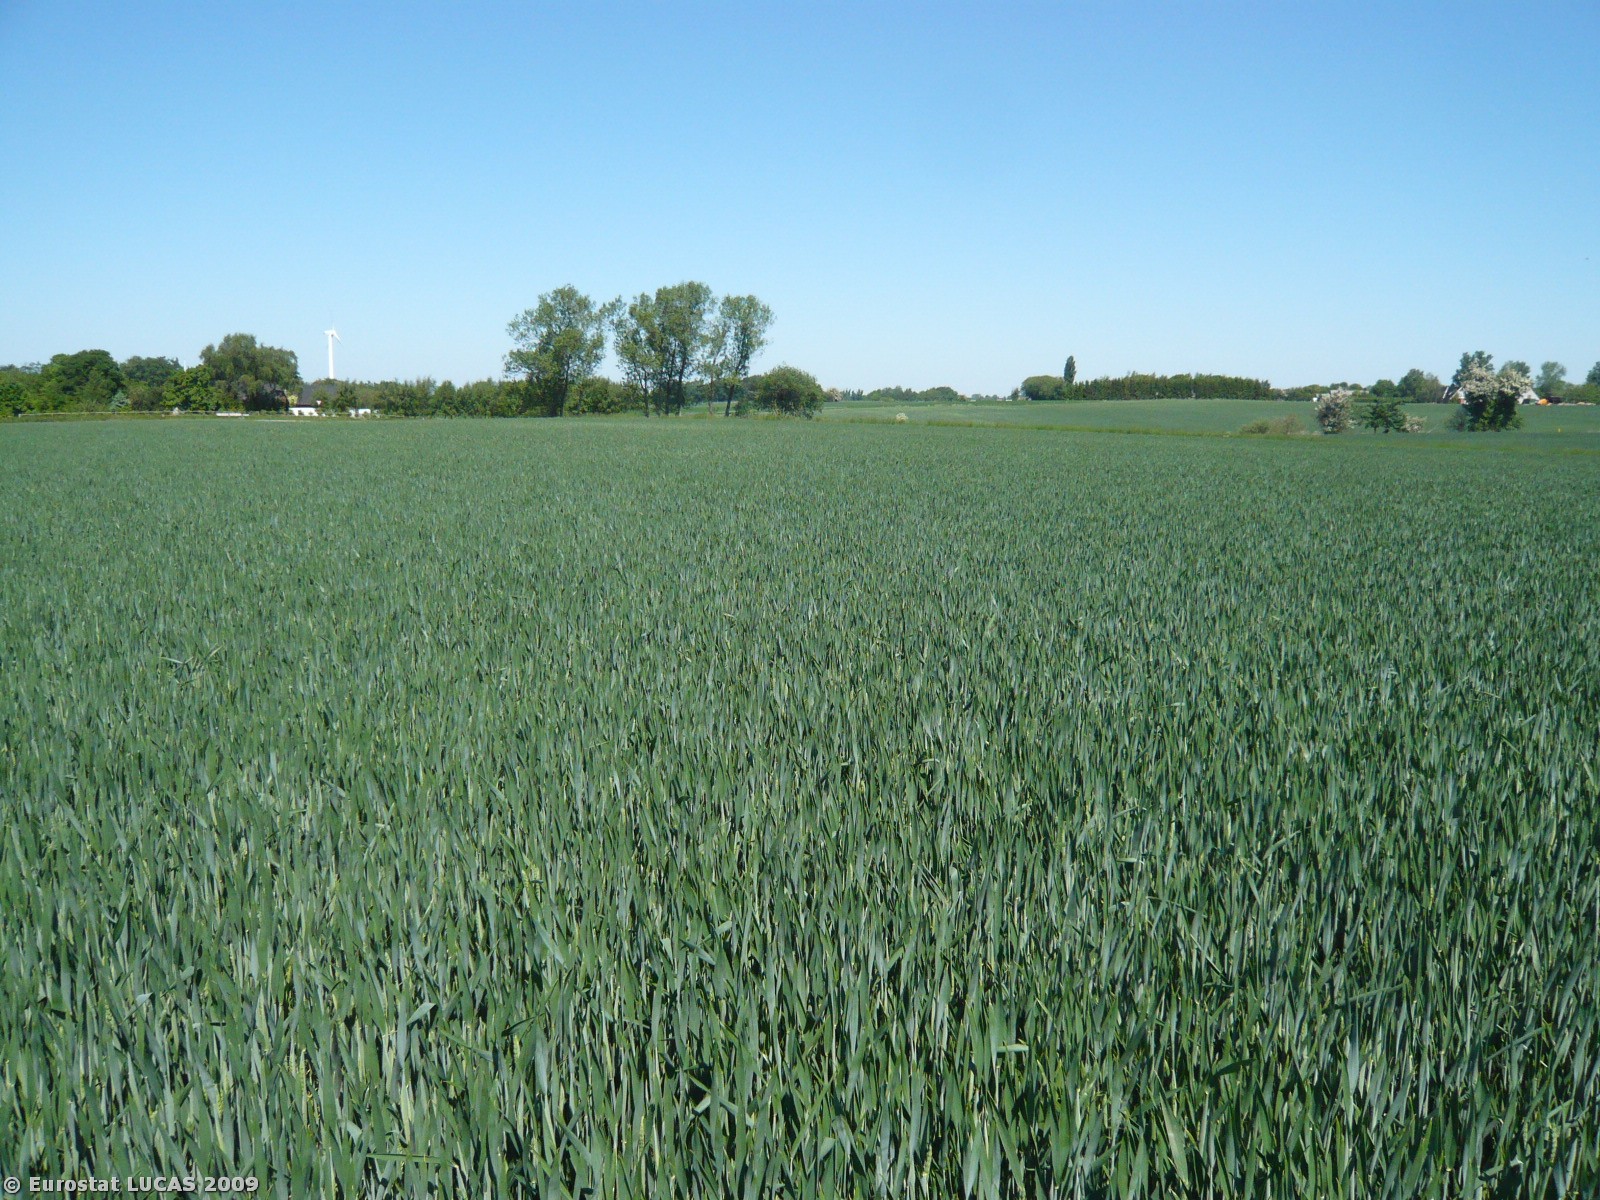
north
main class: Cropland
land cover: Common wheat
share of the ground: > 75 %
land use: Agriculture (excluding fallow land and kitchen gardens)
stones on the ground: < 10 %
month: June
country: DK
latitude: 55.6664
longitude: 12.1444
